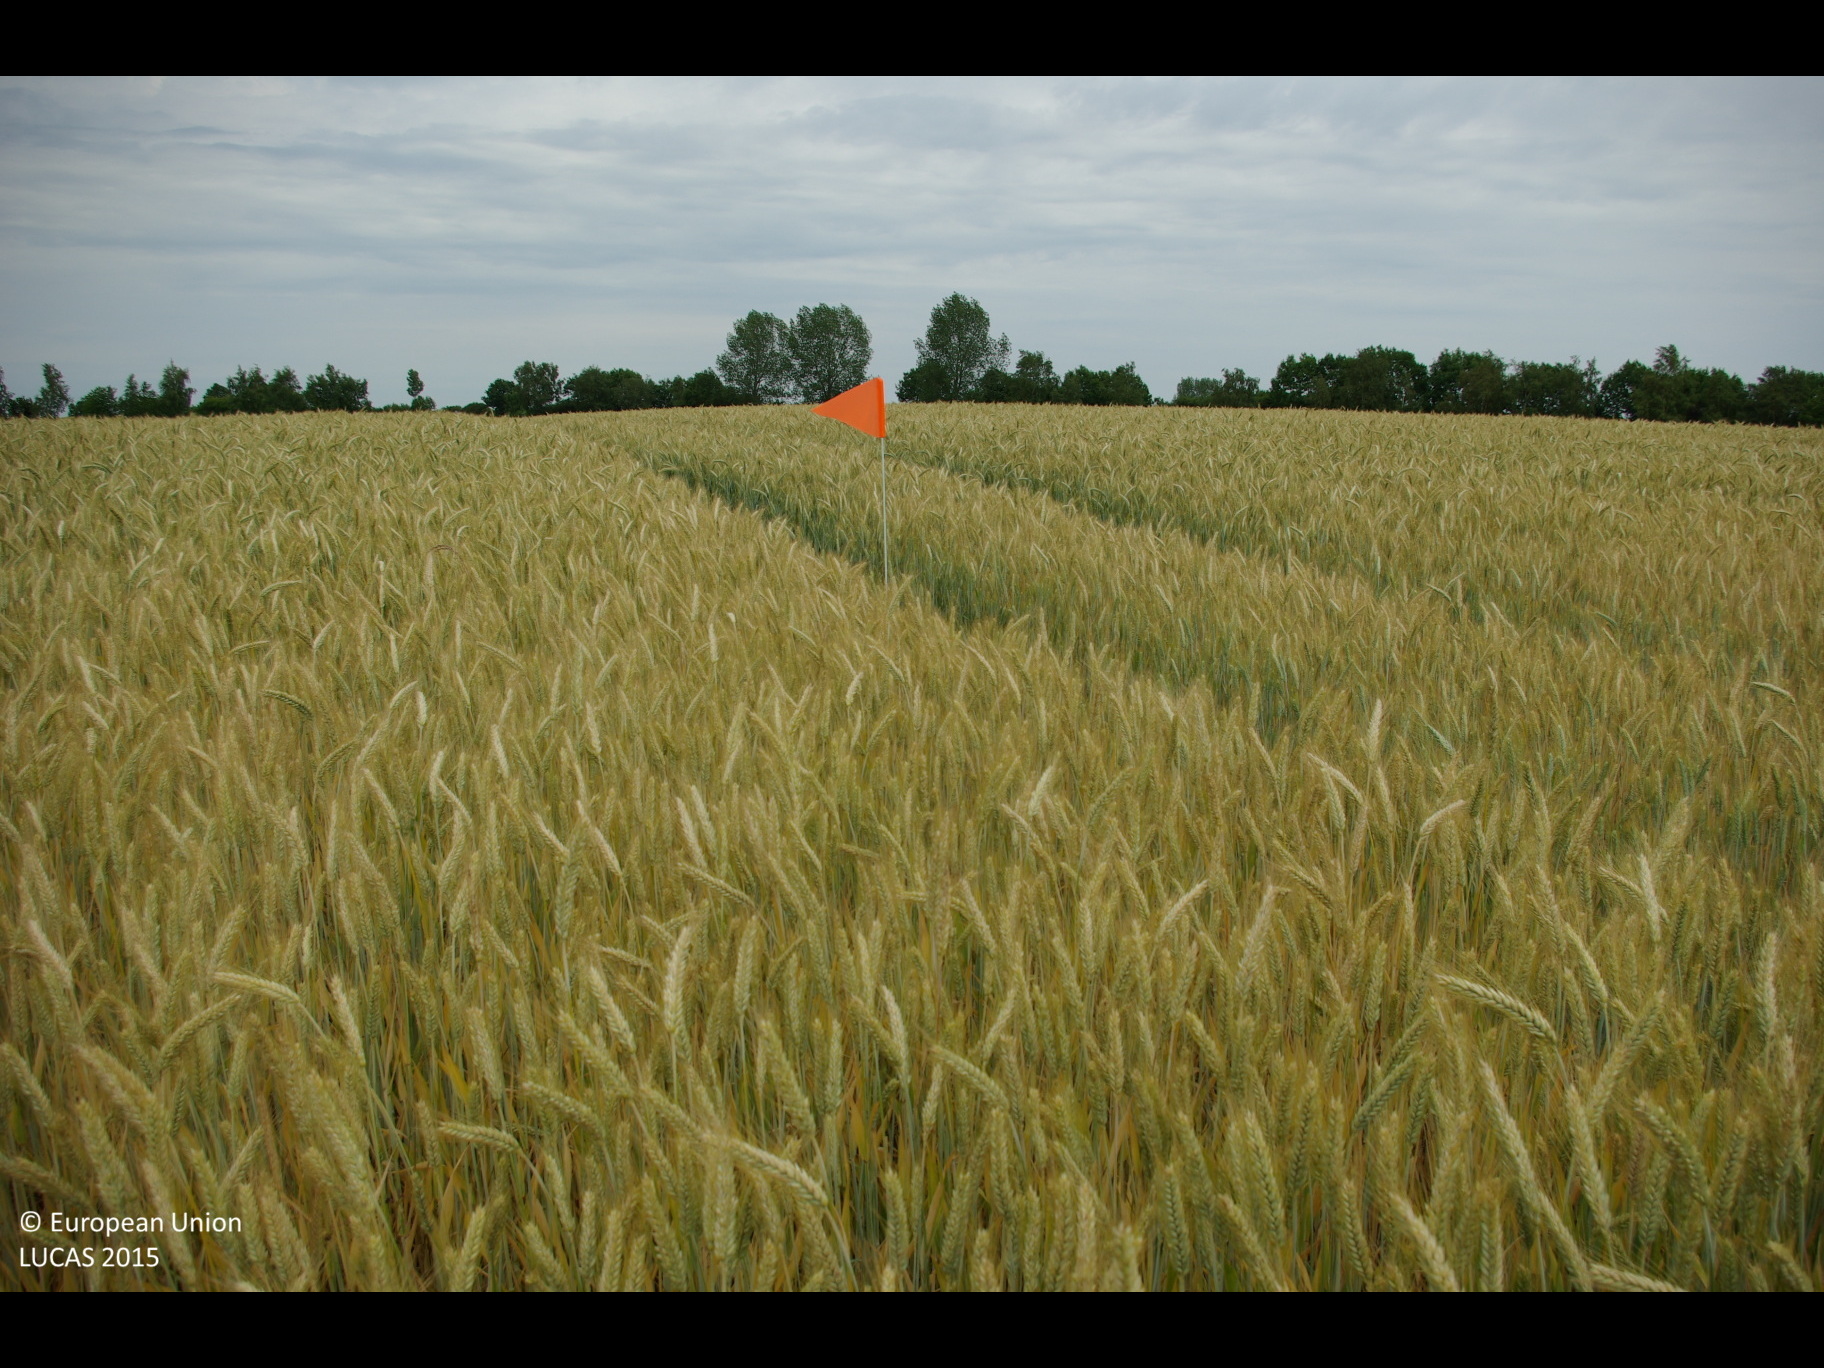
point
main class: Cropland
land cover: Triticale
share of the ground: > 75 %
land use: Agriculture (excluding fallow land and kitchen gardens)
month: July
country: DE
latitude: 54.7498
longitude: 9.9224
